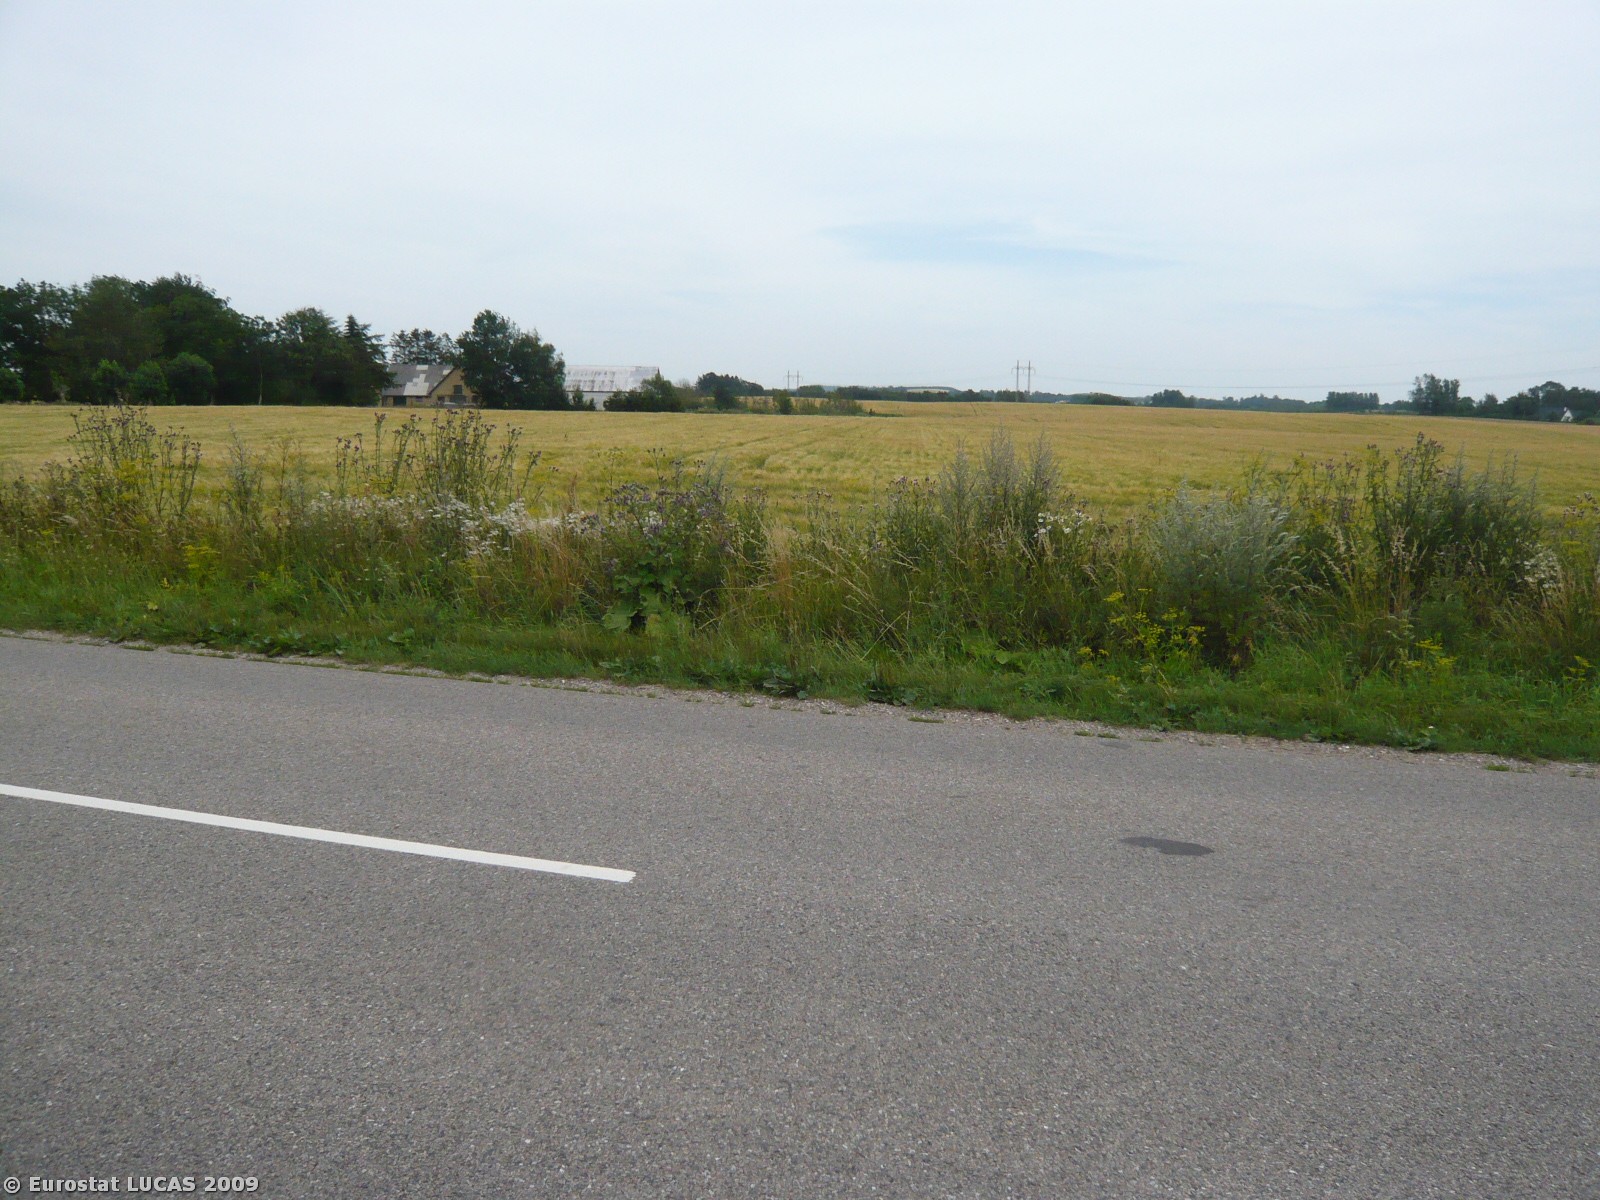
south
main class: Cropland
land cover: Common wheat
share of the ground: > 75 %
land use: Agriculture (excluding fallow land and kitchen gardens)
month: July
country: DK
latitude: 55.5648
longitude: 11.7269
